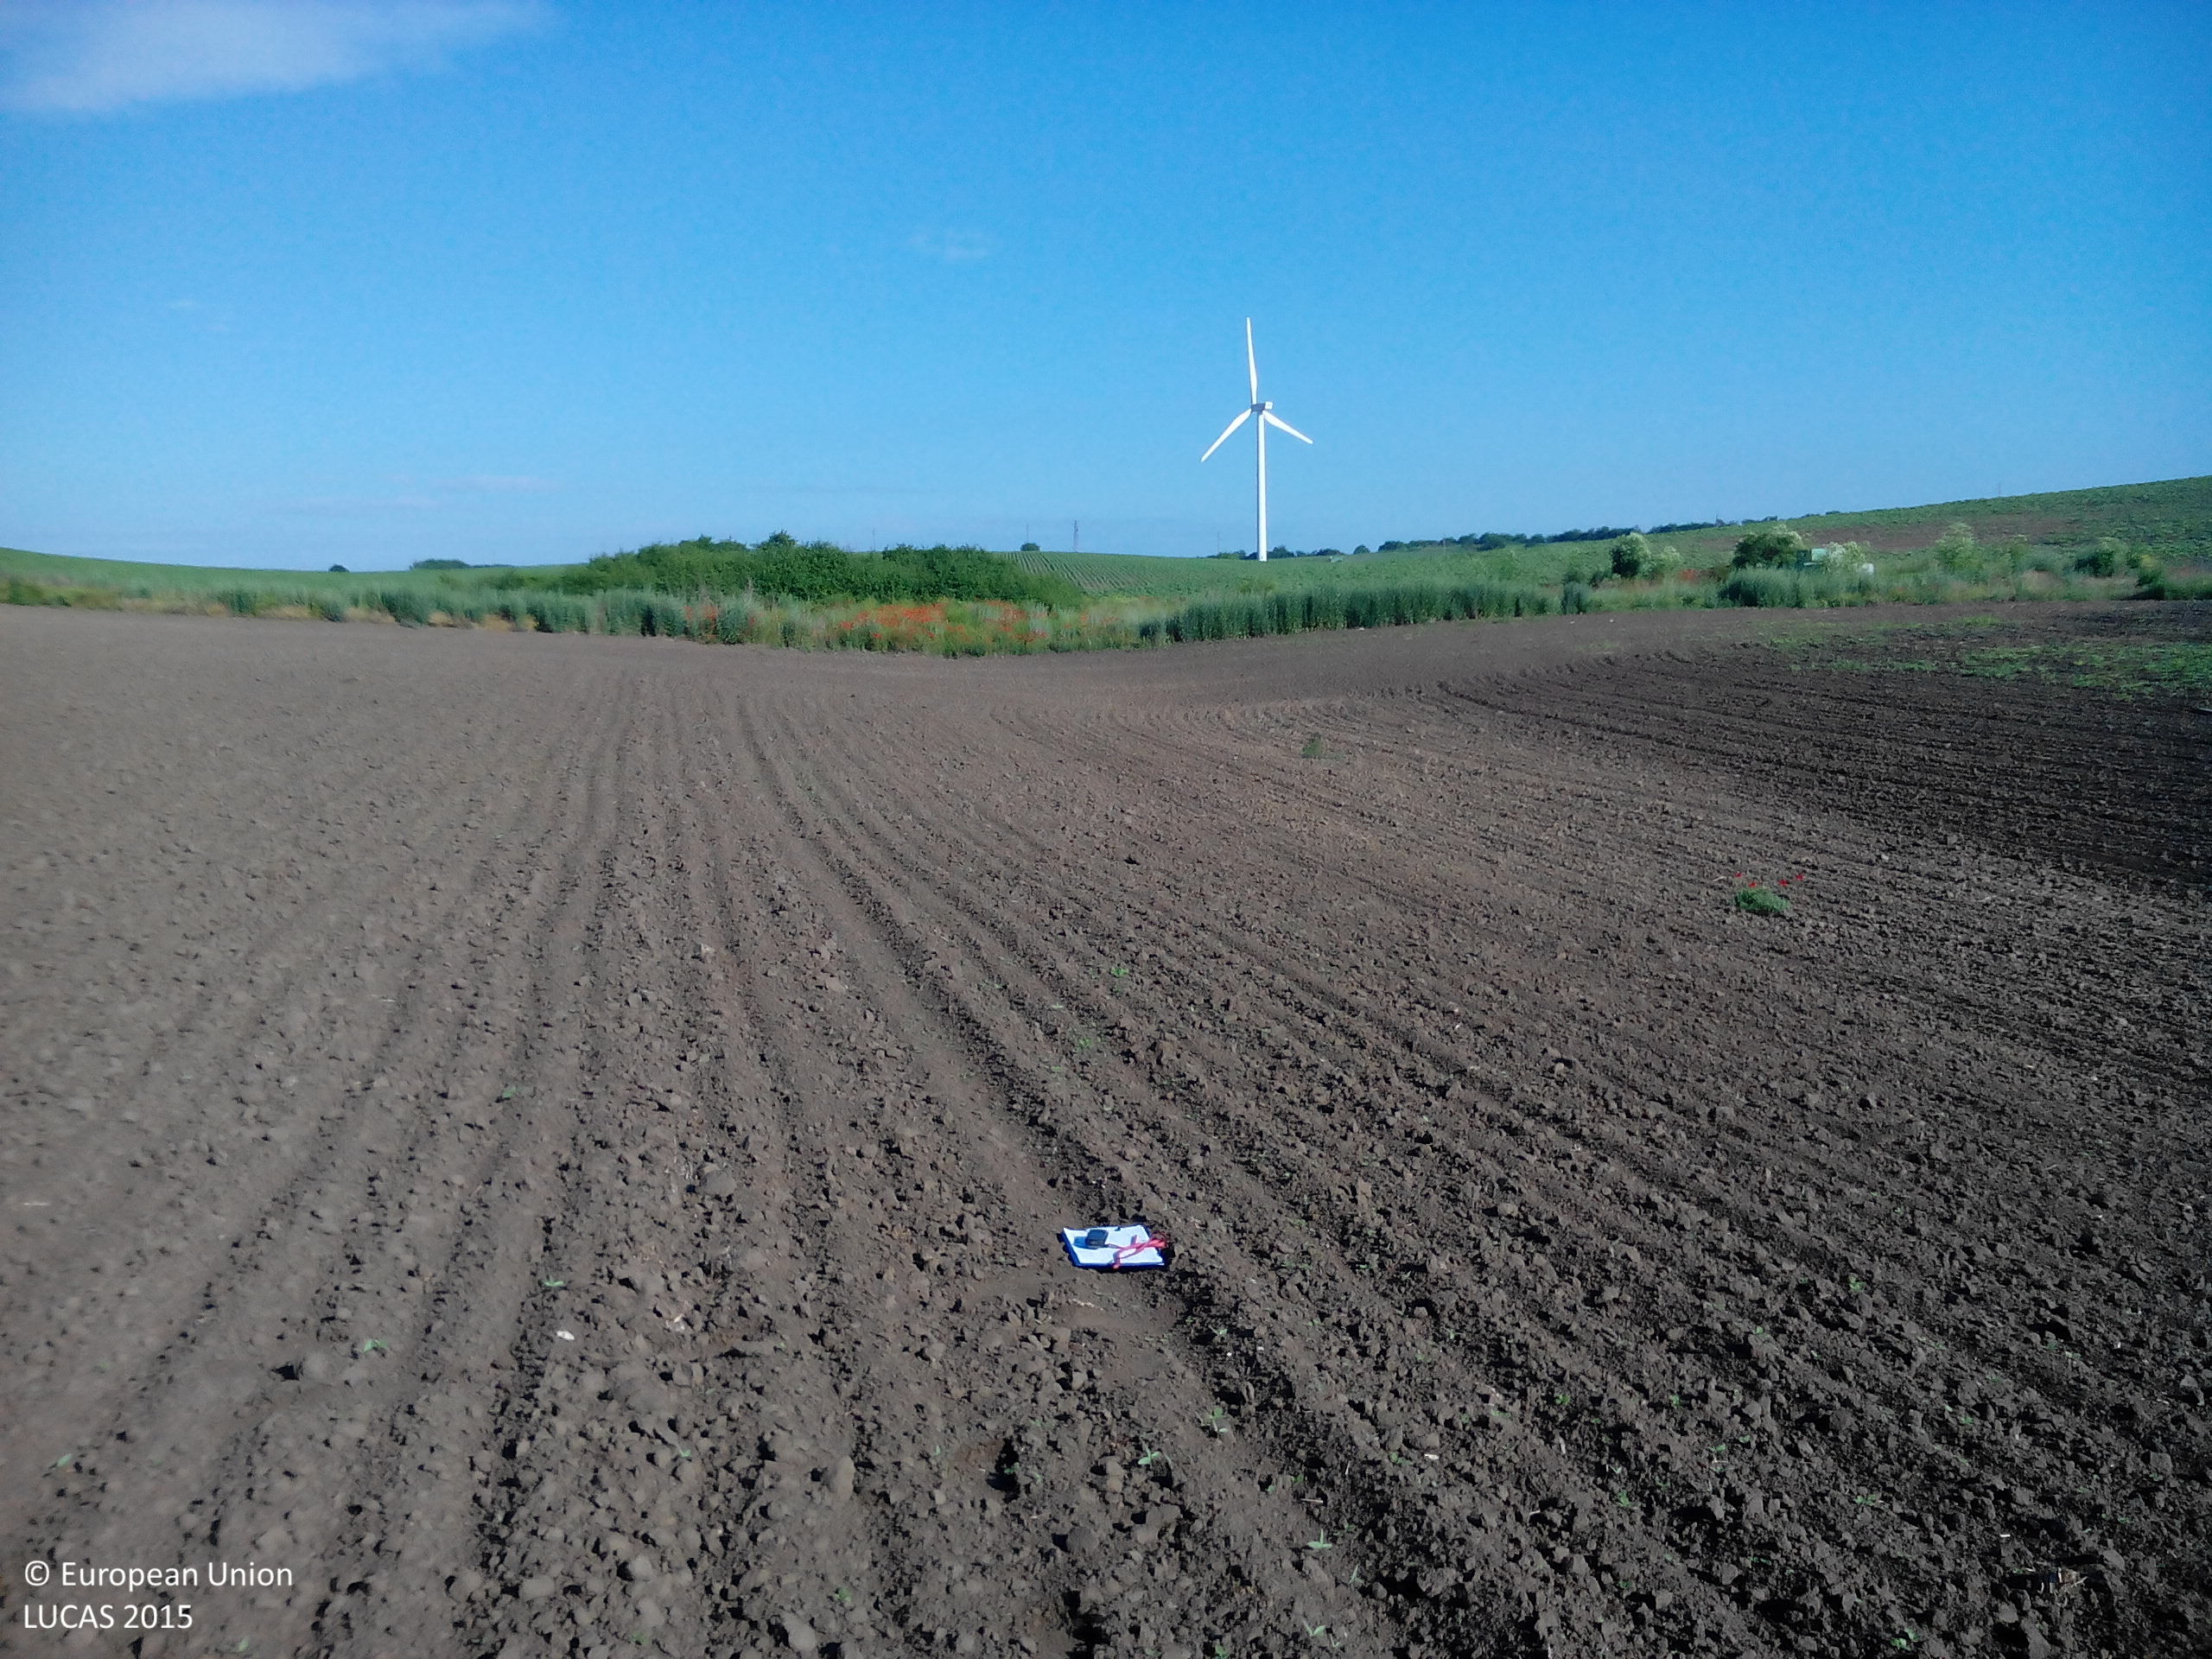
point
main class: Cropland
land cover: Sunflower
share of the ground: < 10 %
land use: Agriculture (excluding fallow land and kitchen gardens)
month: May
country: BG
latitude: 43.6634
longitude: 24.1822
